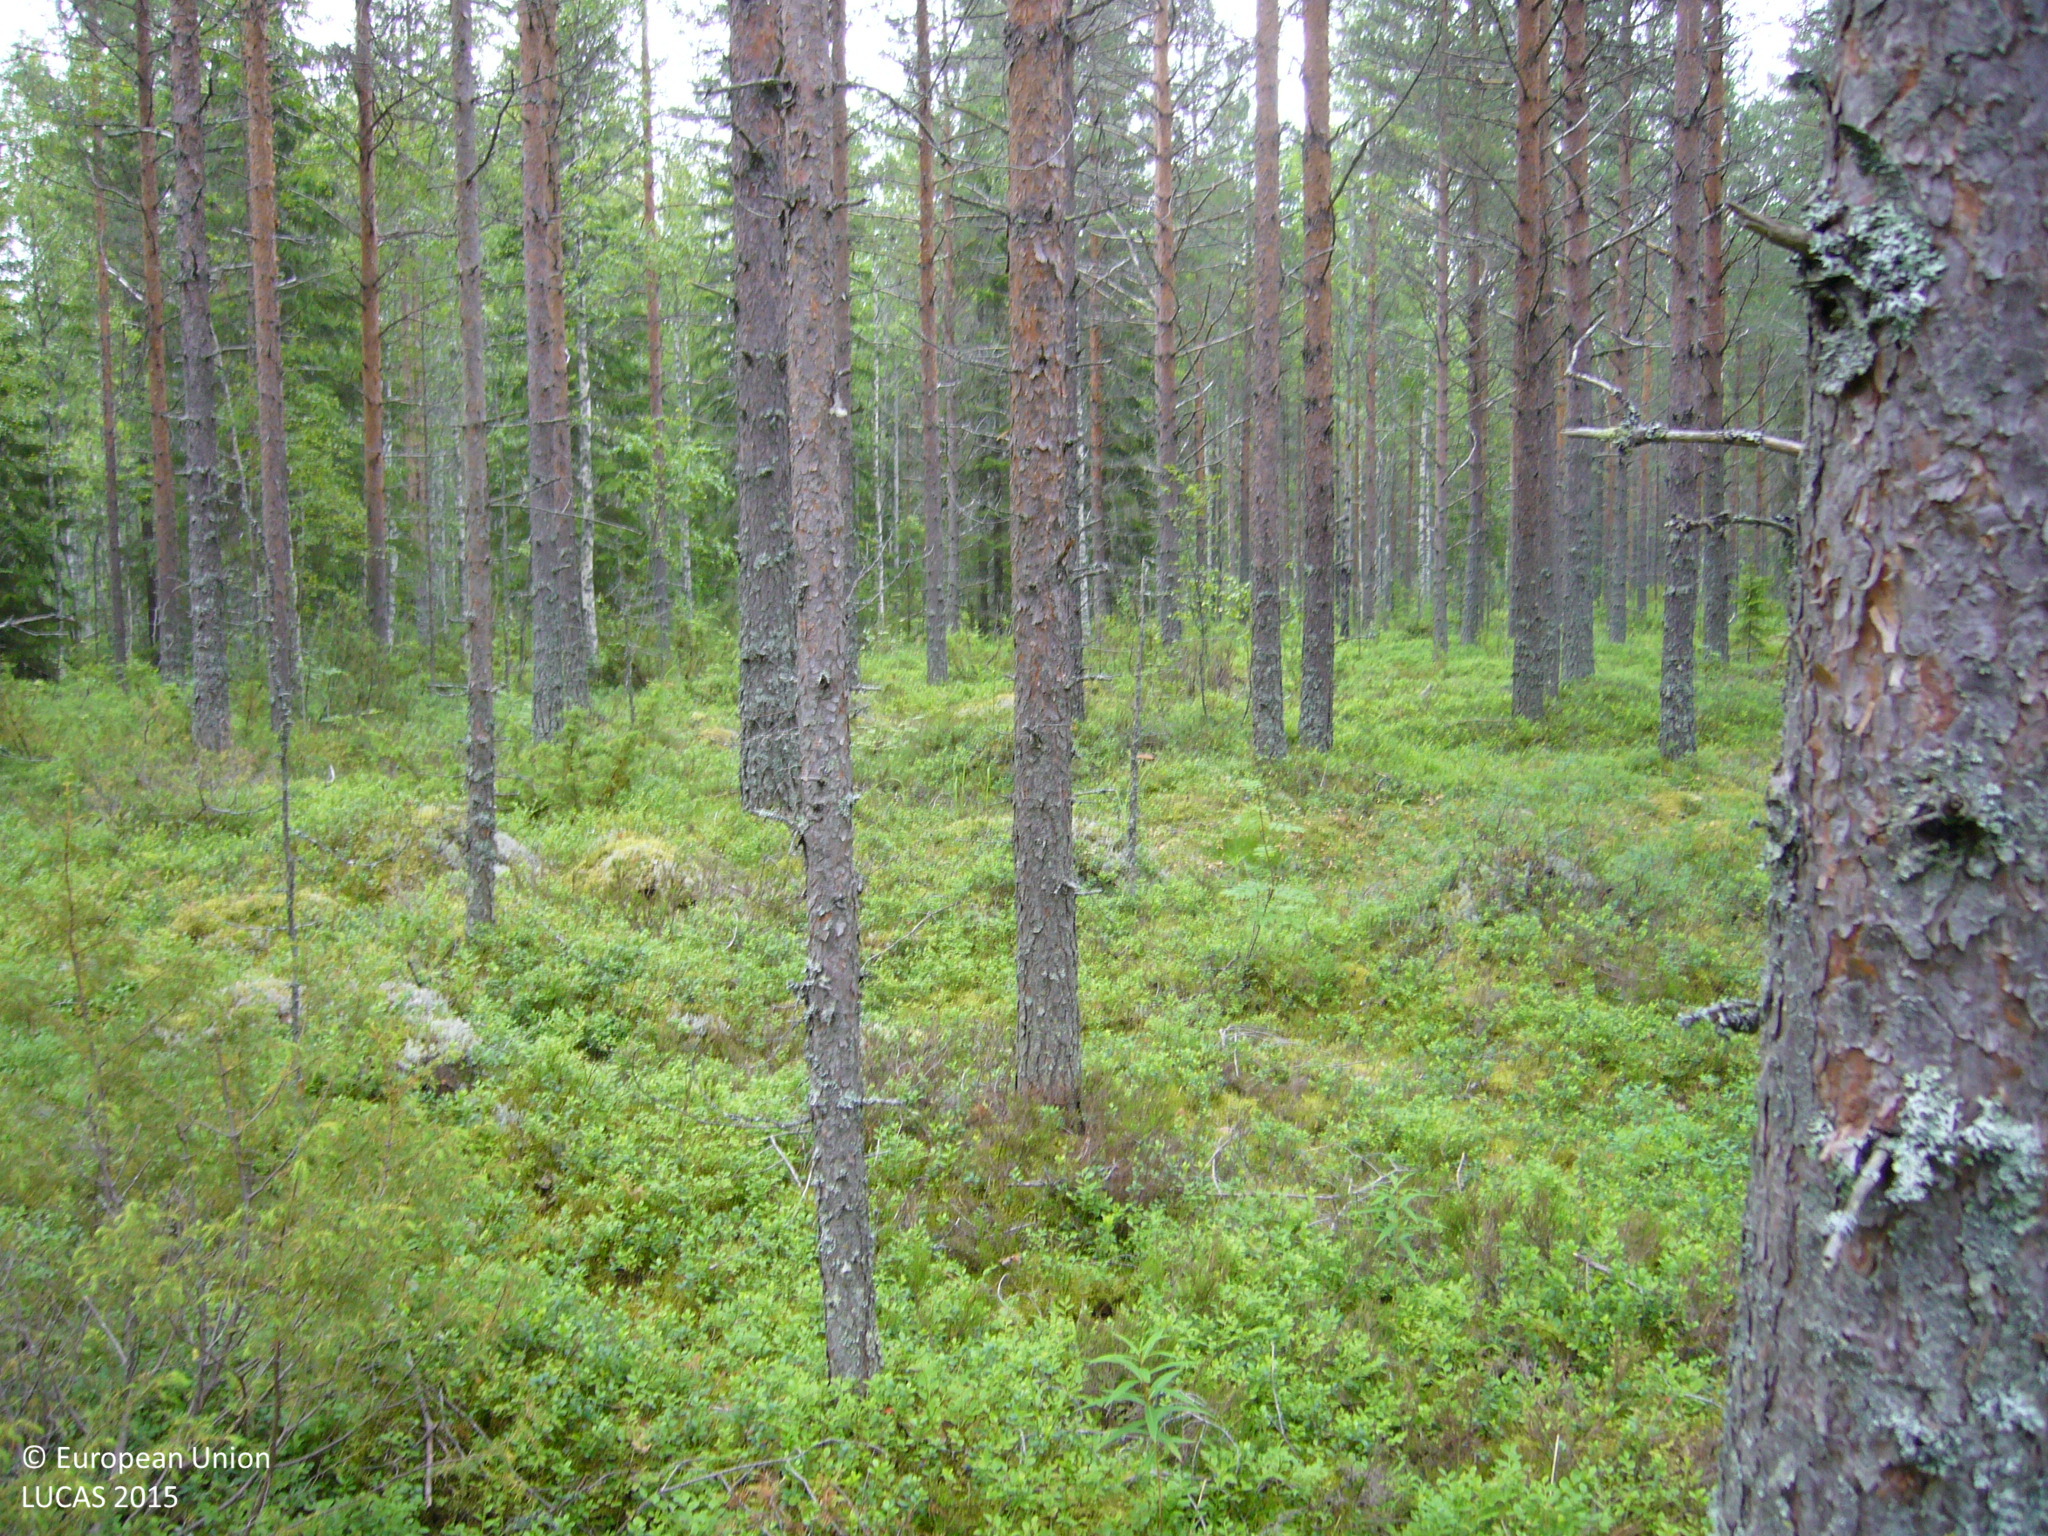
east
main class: Woodland
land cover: Pine dominated coniferous woodland
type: boreal forest
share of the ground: 50 - 75 %
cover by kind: coniferous forest trees 50 %, shrubs 50 %
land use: Forestry
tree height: > 5 m
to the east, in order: Pine dominated coniferous woodland; Other mixed woodland; Ditches and canals; Other mixed woodland; Ditches and canals; Other mixed woodland
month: July
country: FI
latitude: 63.9183
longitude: 25.5716
